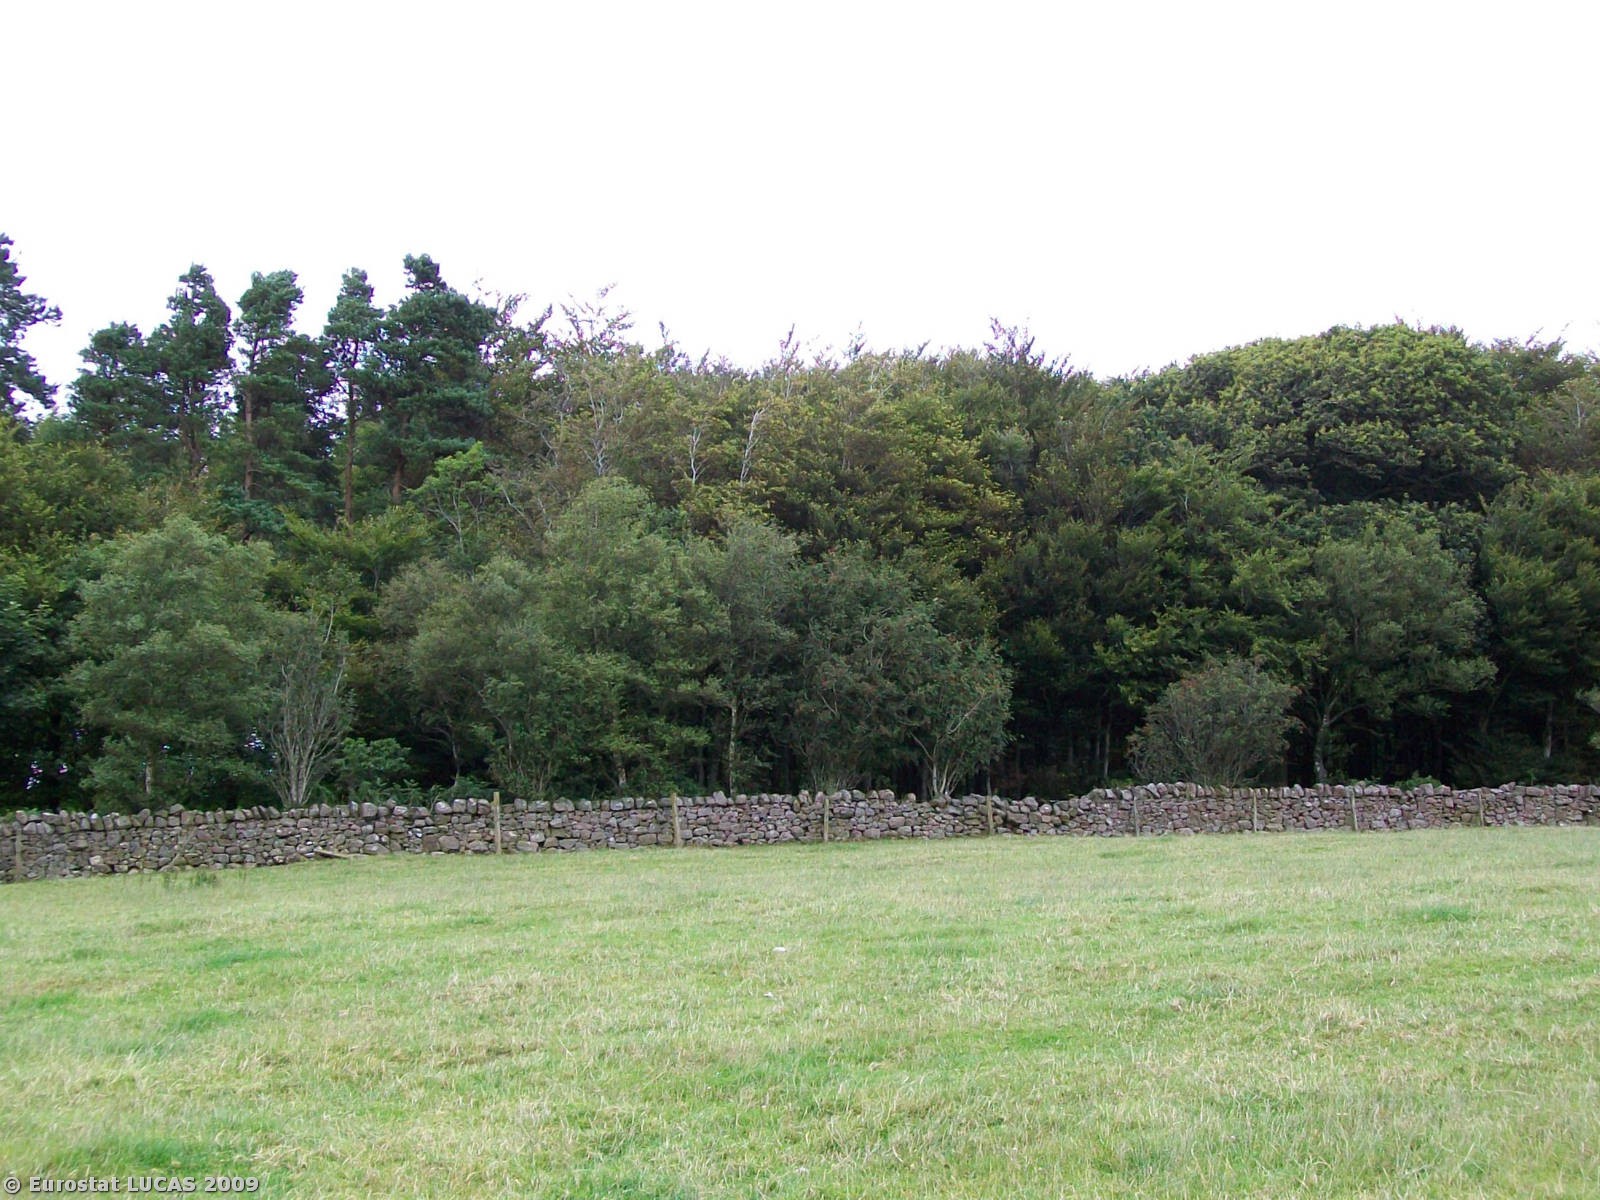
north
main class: Grassland
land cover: Grassland without tree/shrub cover
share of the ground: > 75 %
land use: Agriculture (excluding fallow land and kitchen gardens)
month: July
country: GB
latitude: 55.0353
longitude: -3.2981
